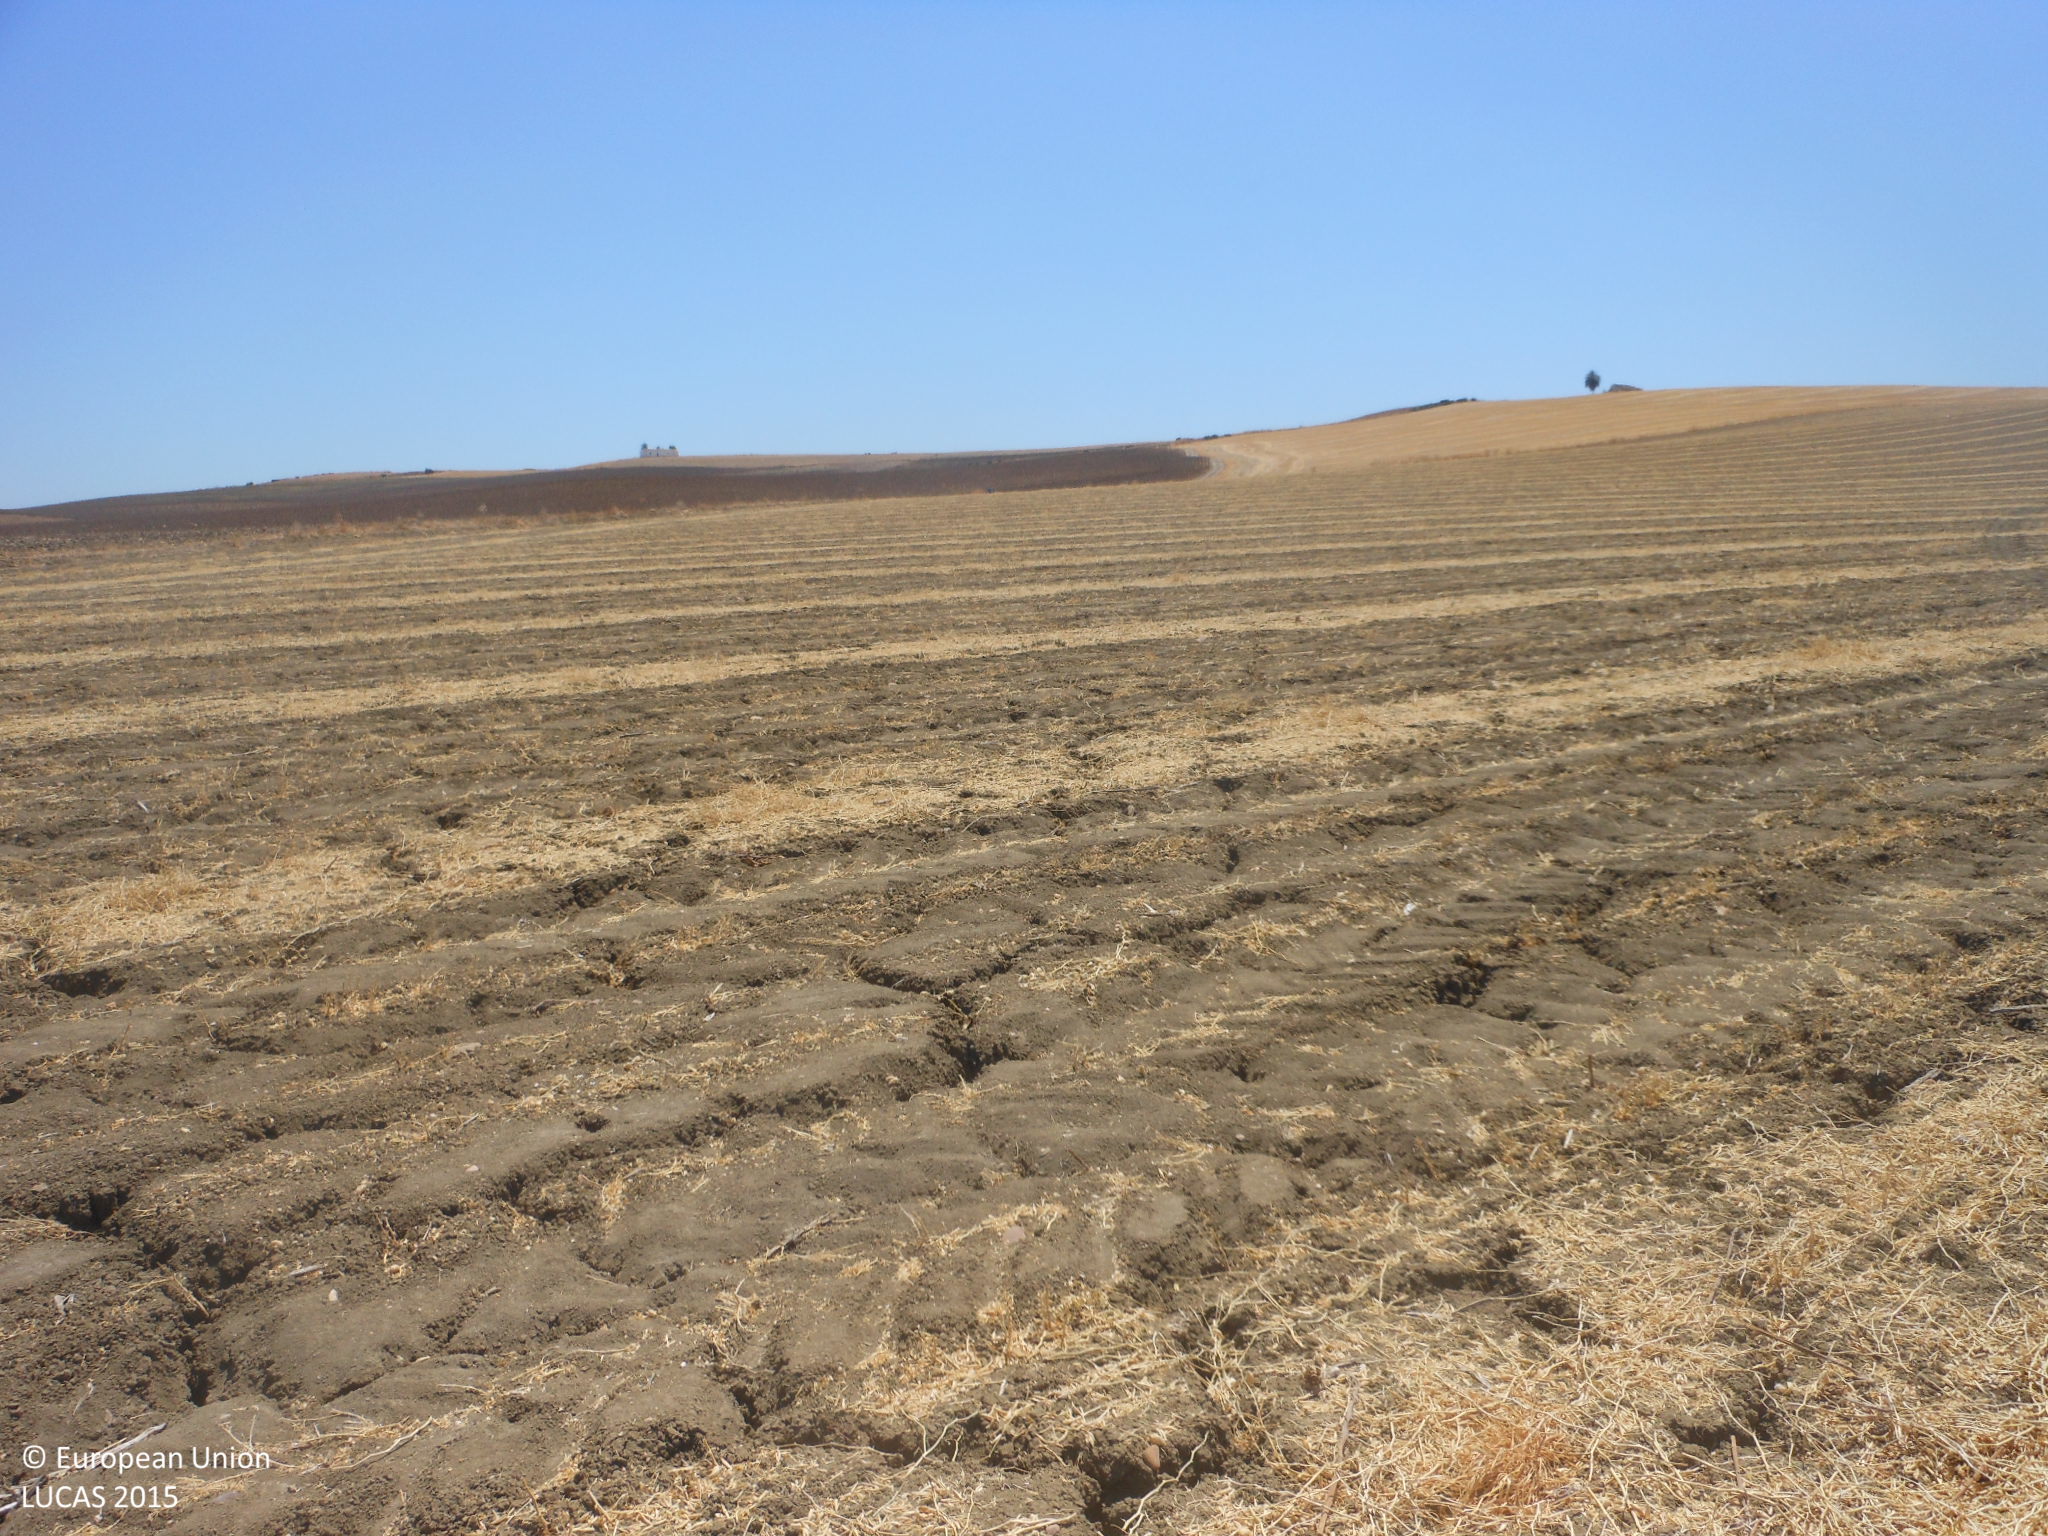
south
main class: Cropland
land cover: Dry pulses
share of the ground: < 10 %
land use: Agriculture (excluding fallow land and kitchen gardens)
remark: Harvested field
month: July
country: ES
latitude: 37.5201
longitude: -5.6000
